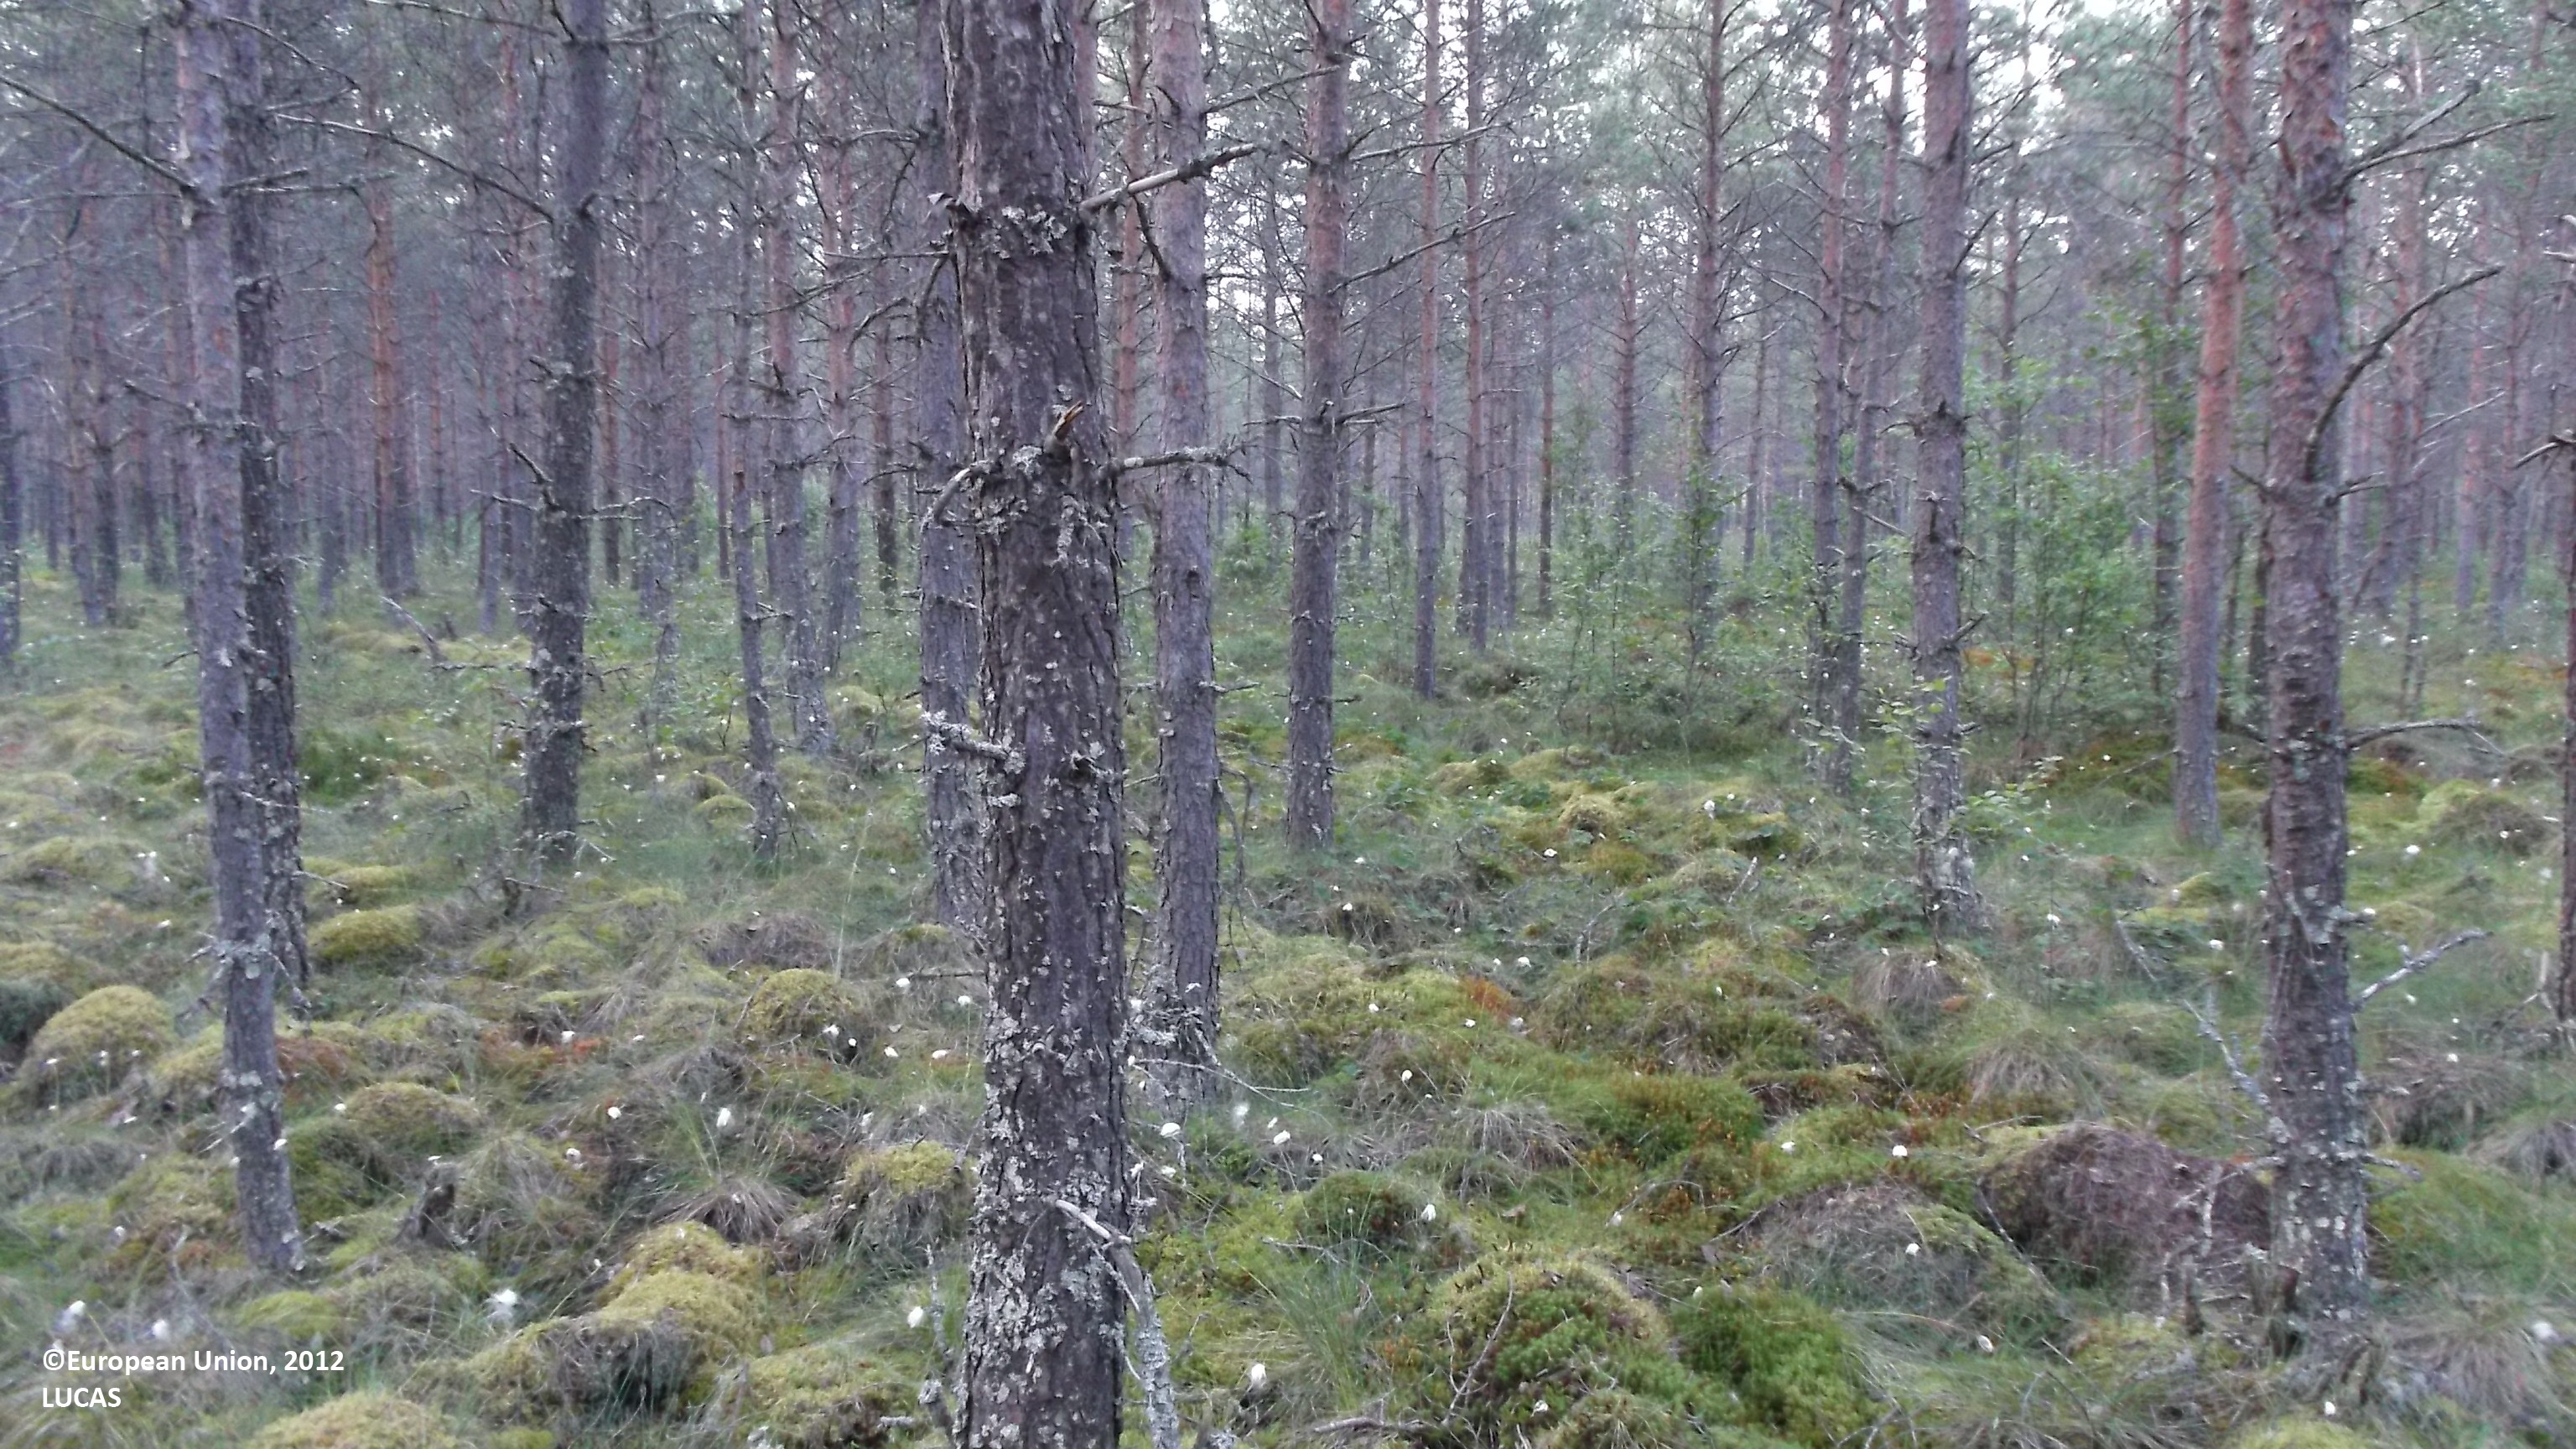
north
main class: Woodland
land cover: Pine dominated coniferous woodland
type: mire and swamp forests
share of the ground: 25 - 50 %
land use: Semi-natural and natural areas not in use
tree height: > 5 m
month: July
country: FI
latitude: 63.3632
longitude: 24.4549
